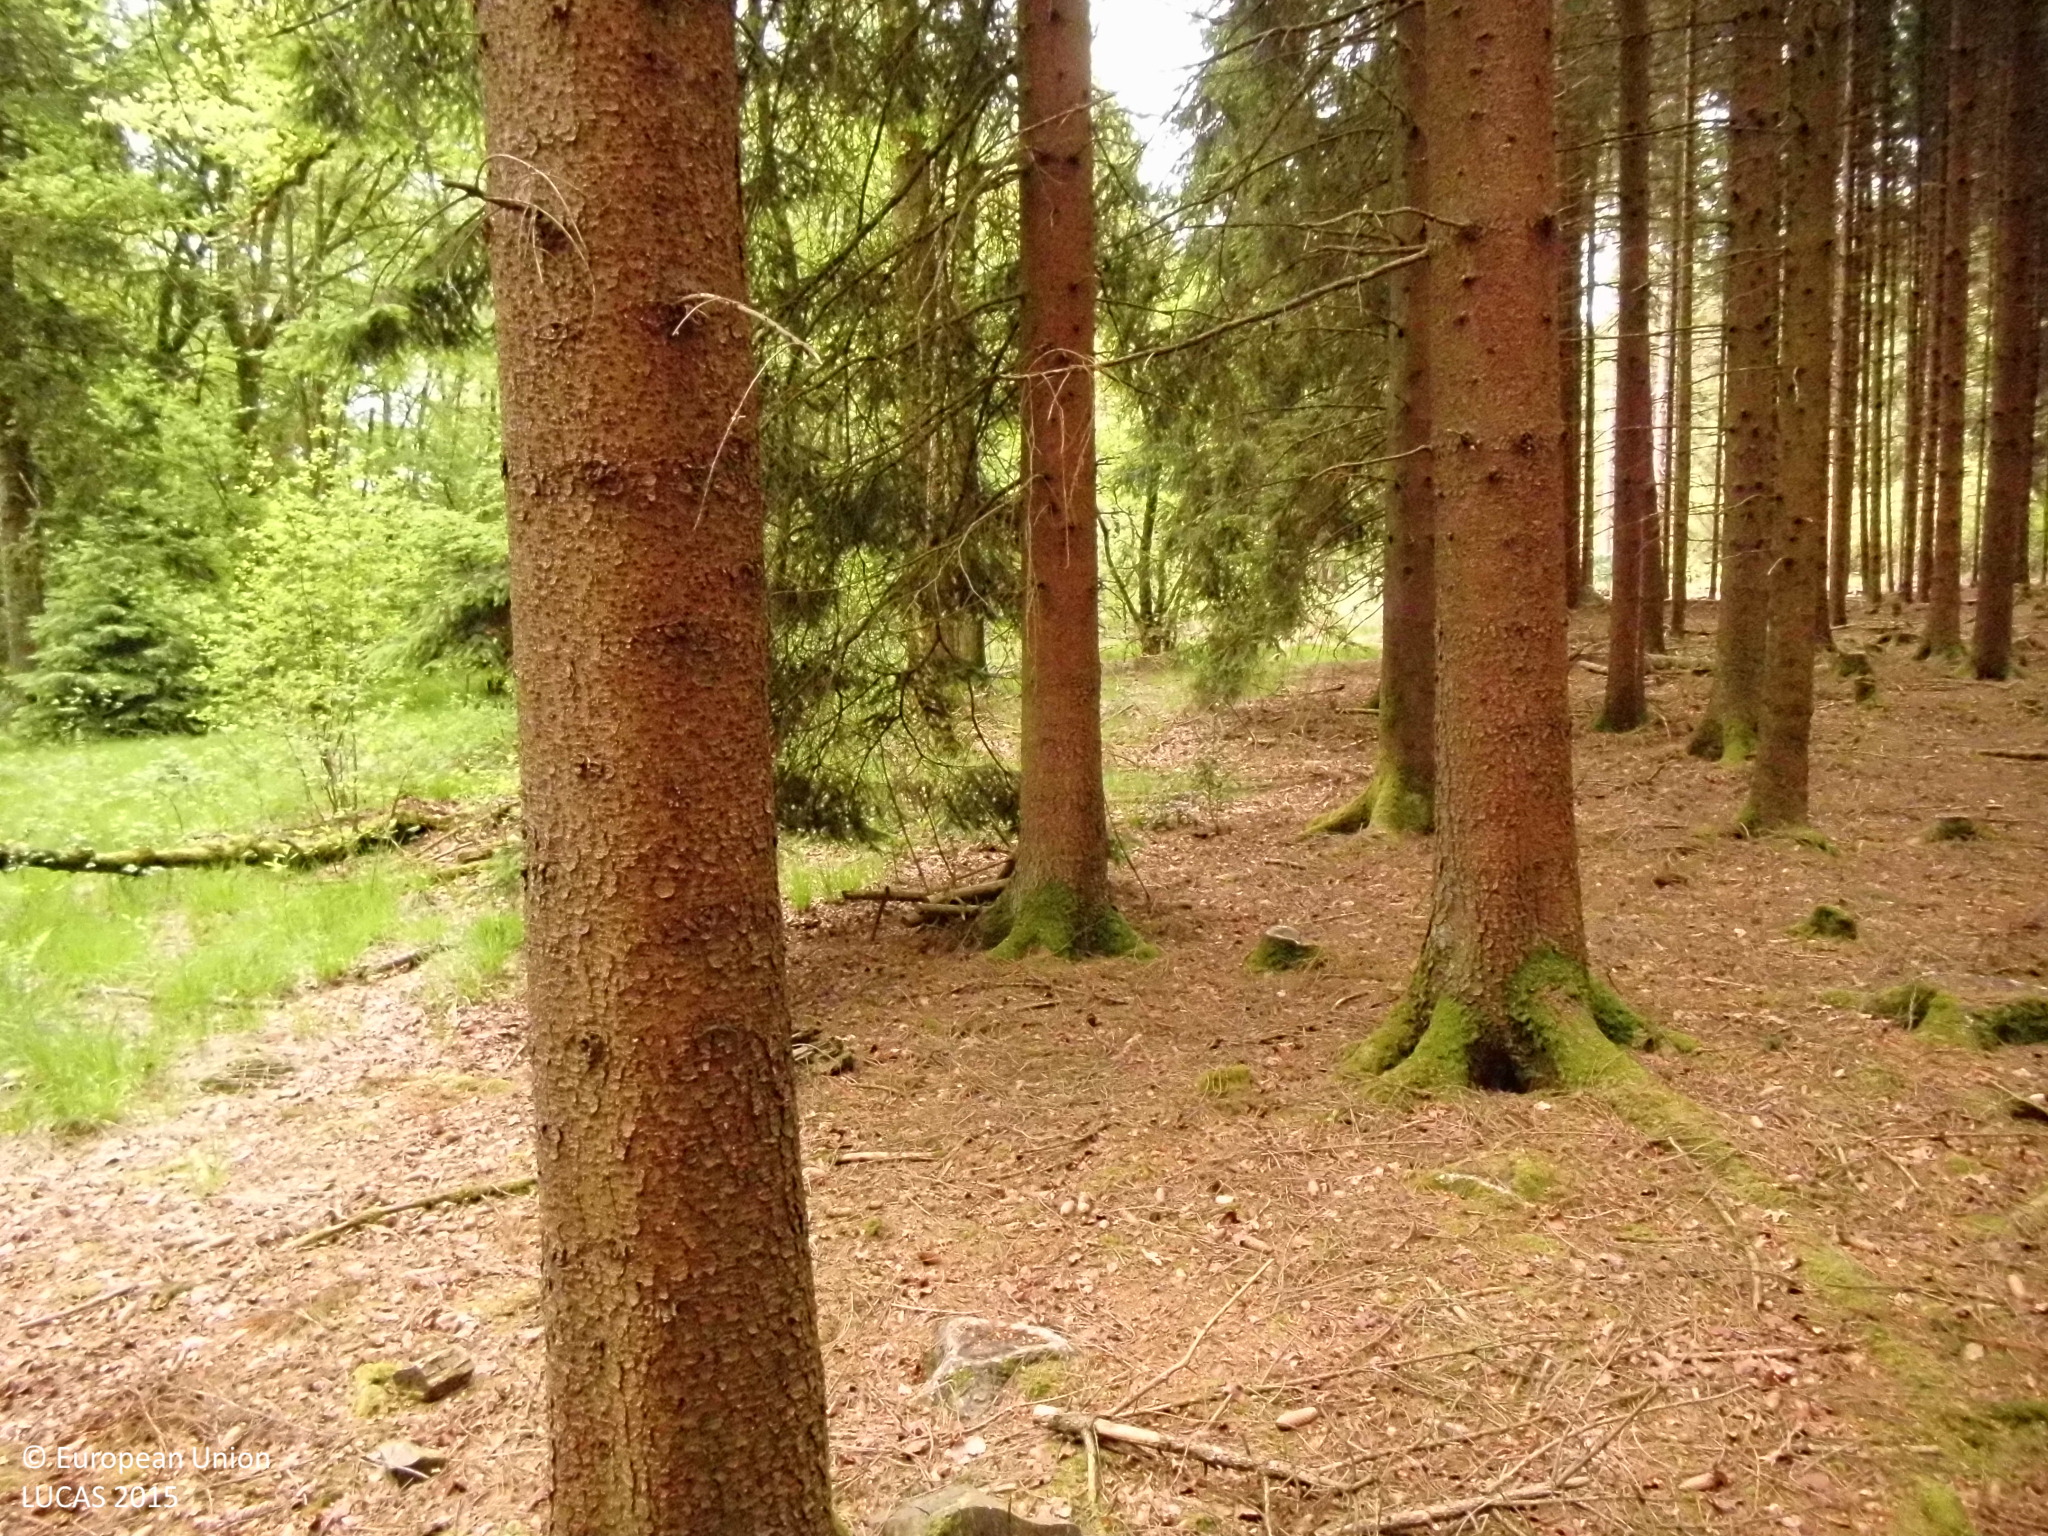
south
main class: Woodland
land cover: Spruce dominated coniferous woodland
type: hemiboreal forest and nemoral coniferous forest and mixed broadleaved-coniferous forest
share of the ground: > 75 %
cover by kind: coniferous forest trees 80 %, unconsolidated bare surface 15 %, herbaceous plants 5 %
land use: Forestry
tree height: > 5 m
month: May
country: DE
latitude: 50.9306
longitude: 7.5103
